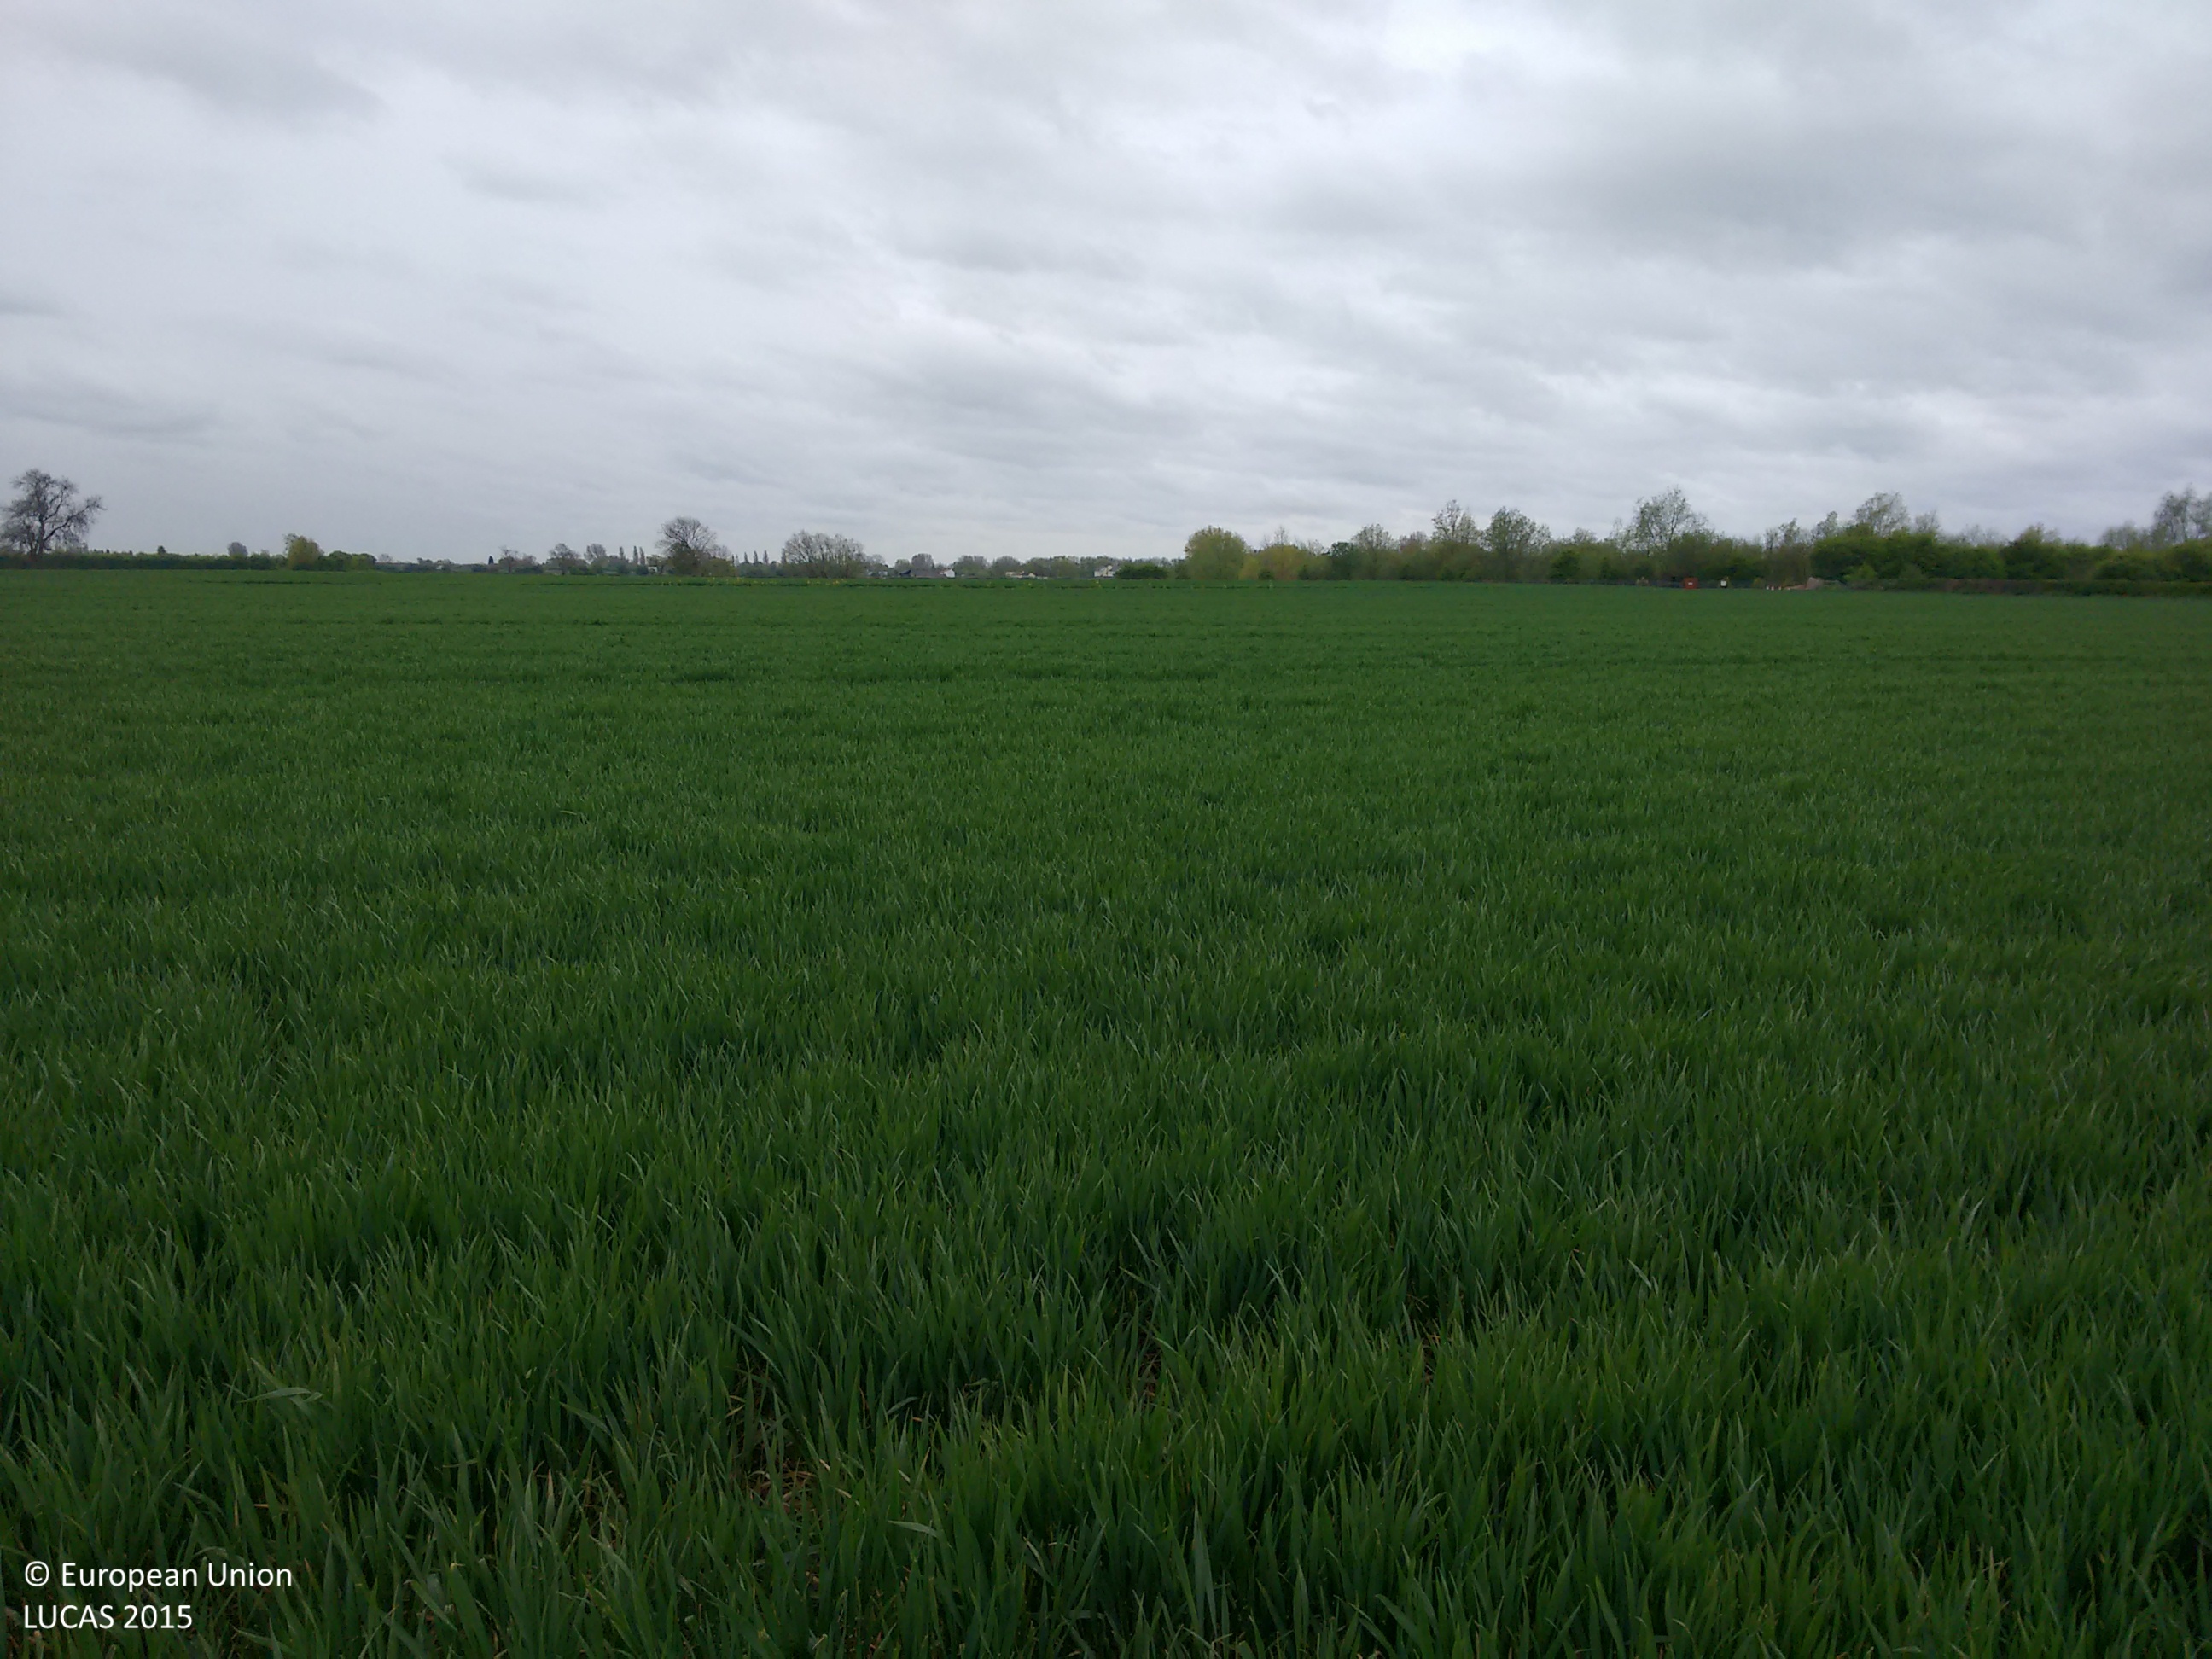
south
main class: Cropland
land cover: Barley
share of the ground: > 75 %
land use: Agriculture (excluding fallow land and kitchen gardens)
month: May
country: GB
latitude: 53.7784
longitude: -0.7075
